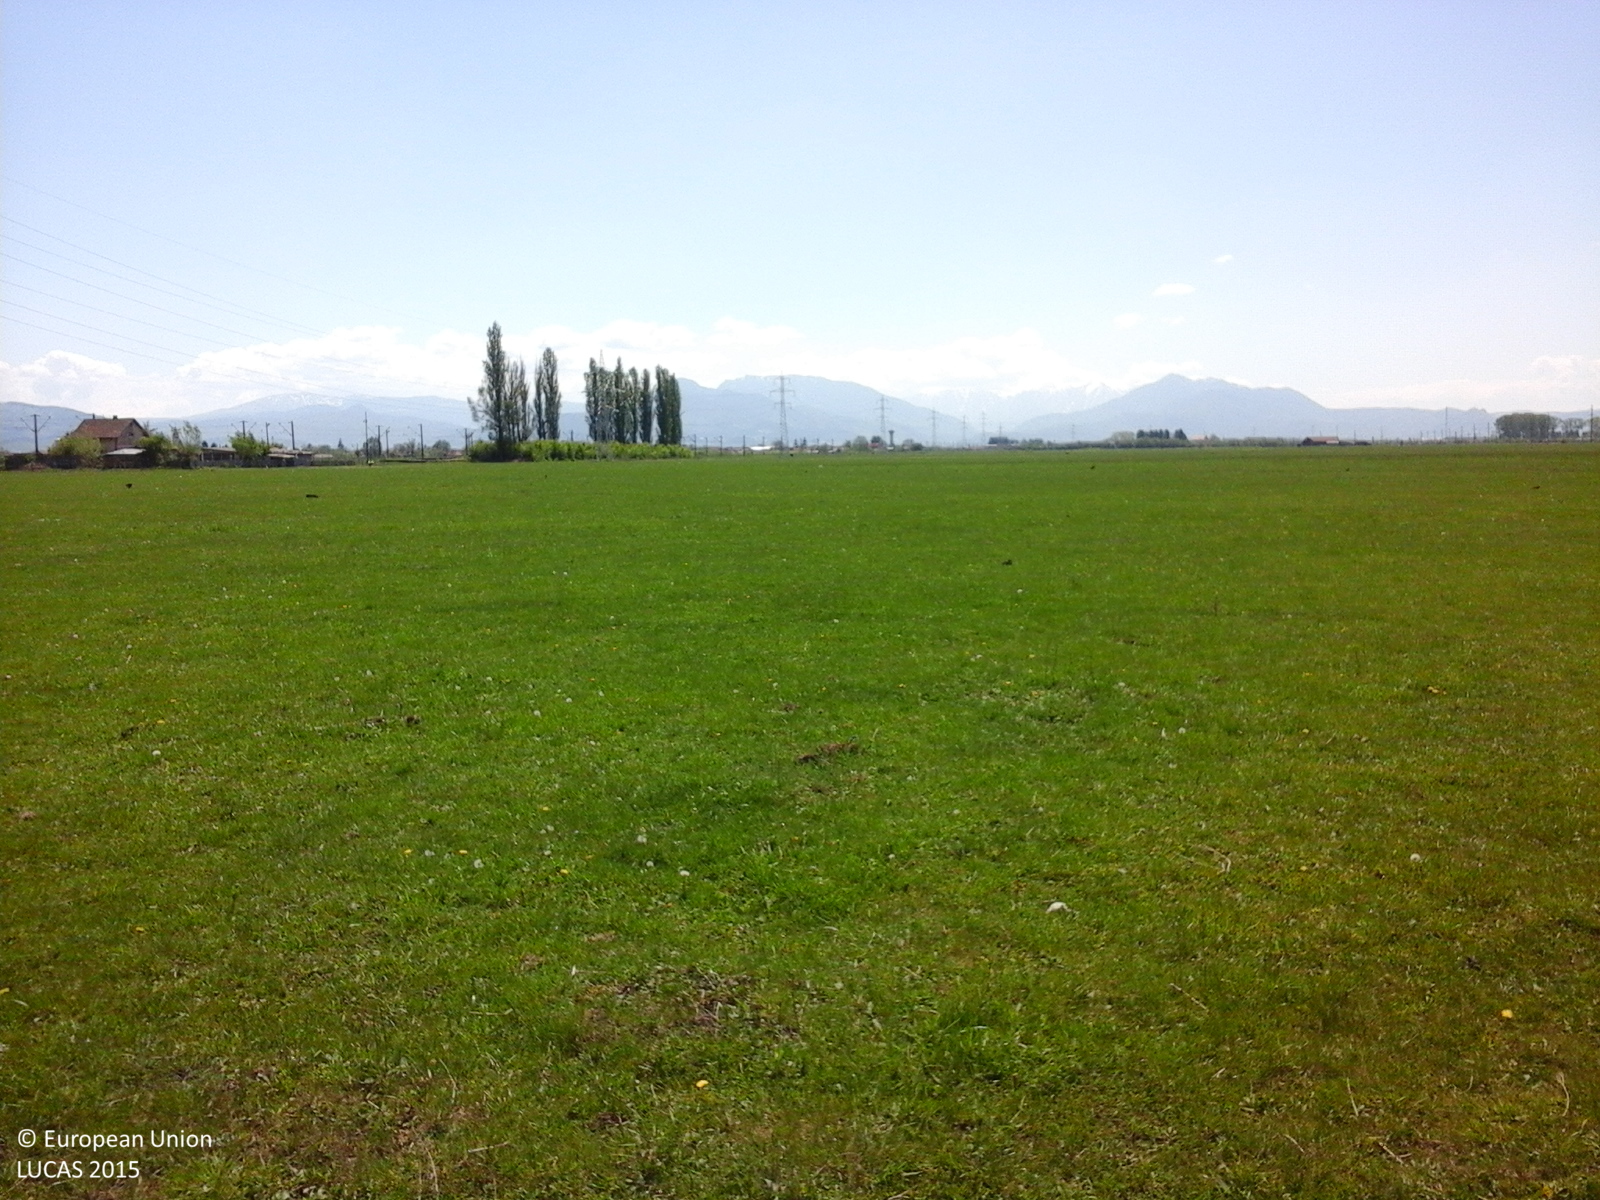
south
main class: Grassland
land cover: Grassland without tree/shrub cover
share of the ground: > 75 %
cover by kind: herbaceous plants 100 %
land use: Agriculture (excluding fallow land and kitchen gardens)
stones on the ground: < 10 %
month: May
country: RO
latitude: 45.7396
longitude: 25.7763
